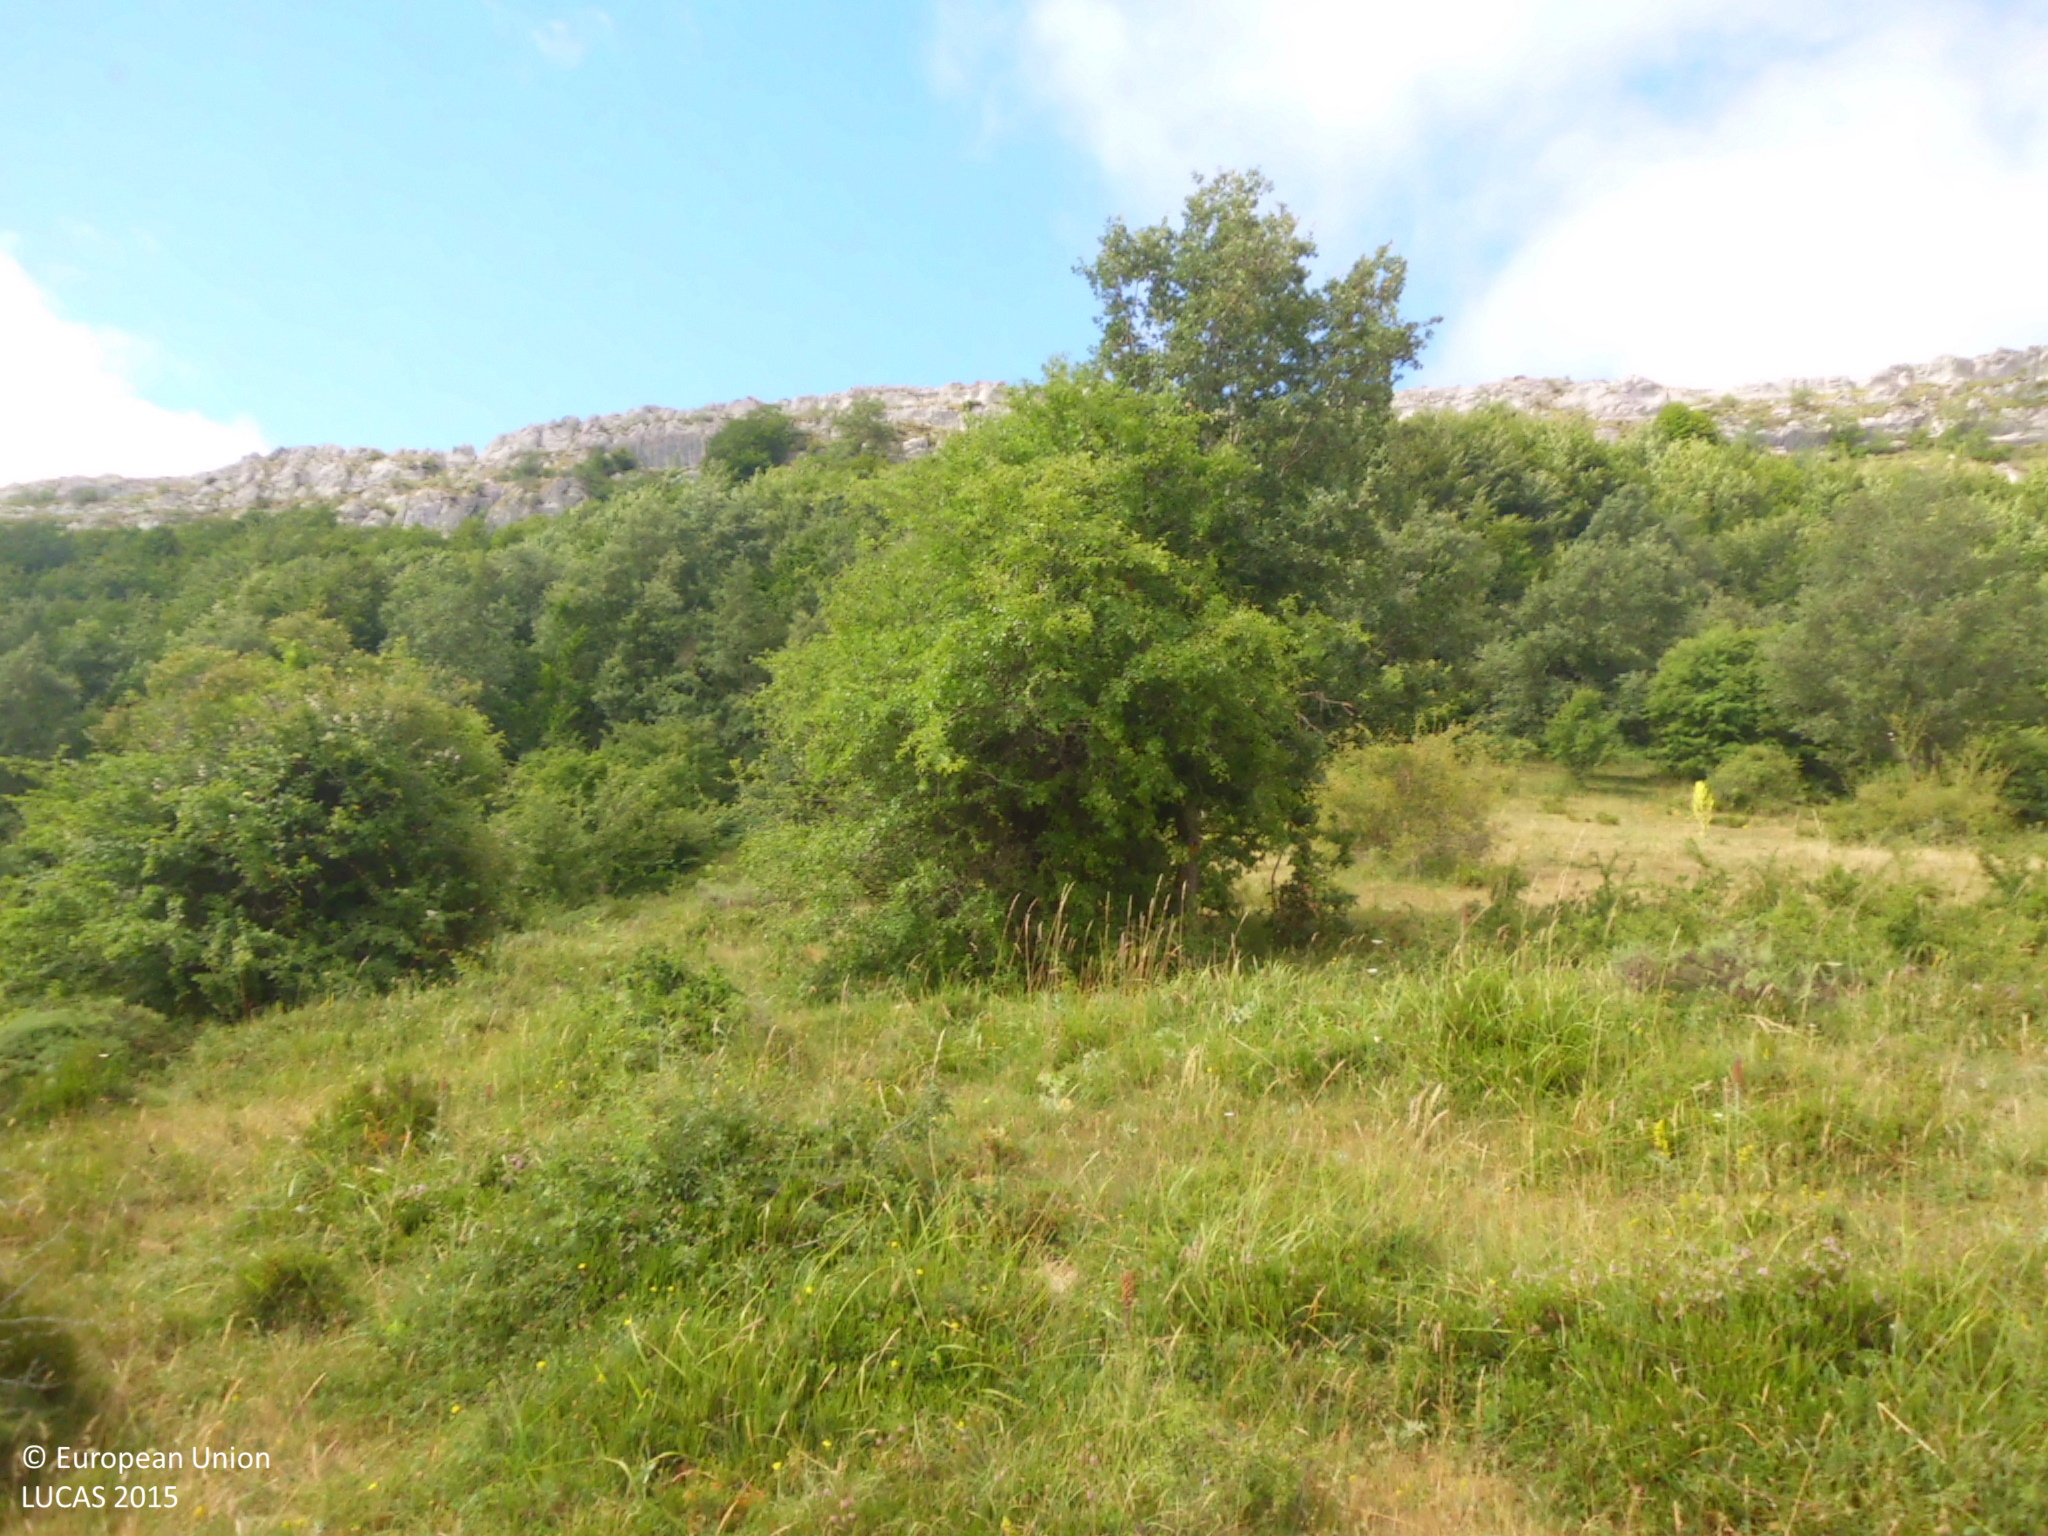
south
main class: Shrubland
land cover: Shrubland without tree cover
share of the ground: 25 - 50 %
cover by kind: herbaceous plants 55 %, shrubs 35 %, consolidated bare surface 10 %
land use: Agriculture (excluding fallow land and kitchen gardens)
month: July
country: ES
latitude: 42.7055
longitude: -4.0985
